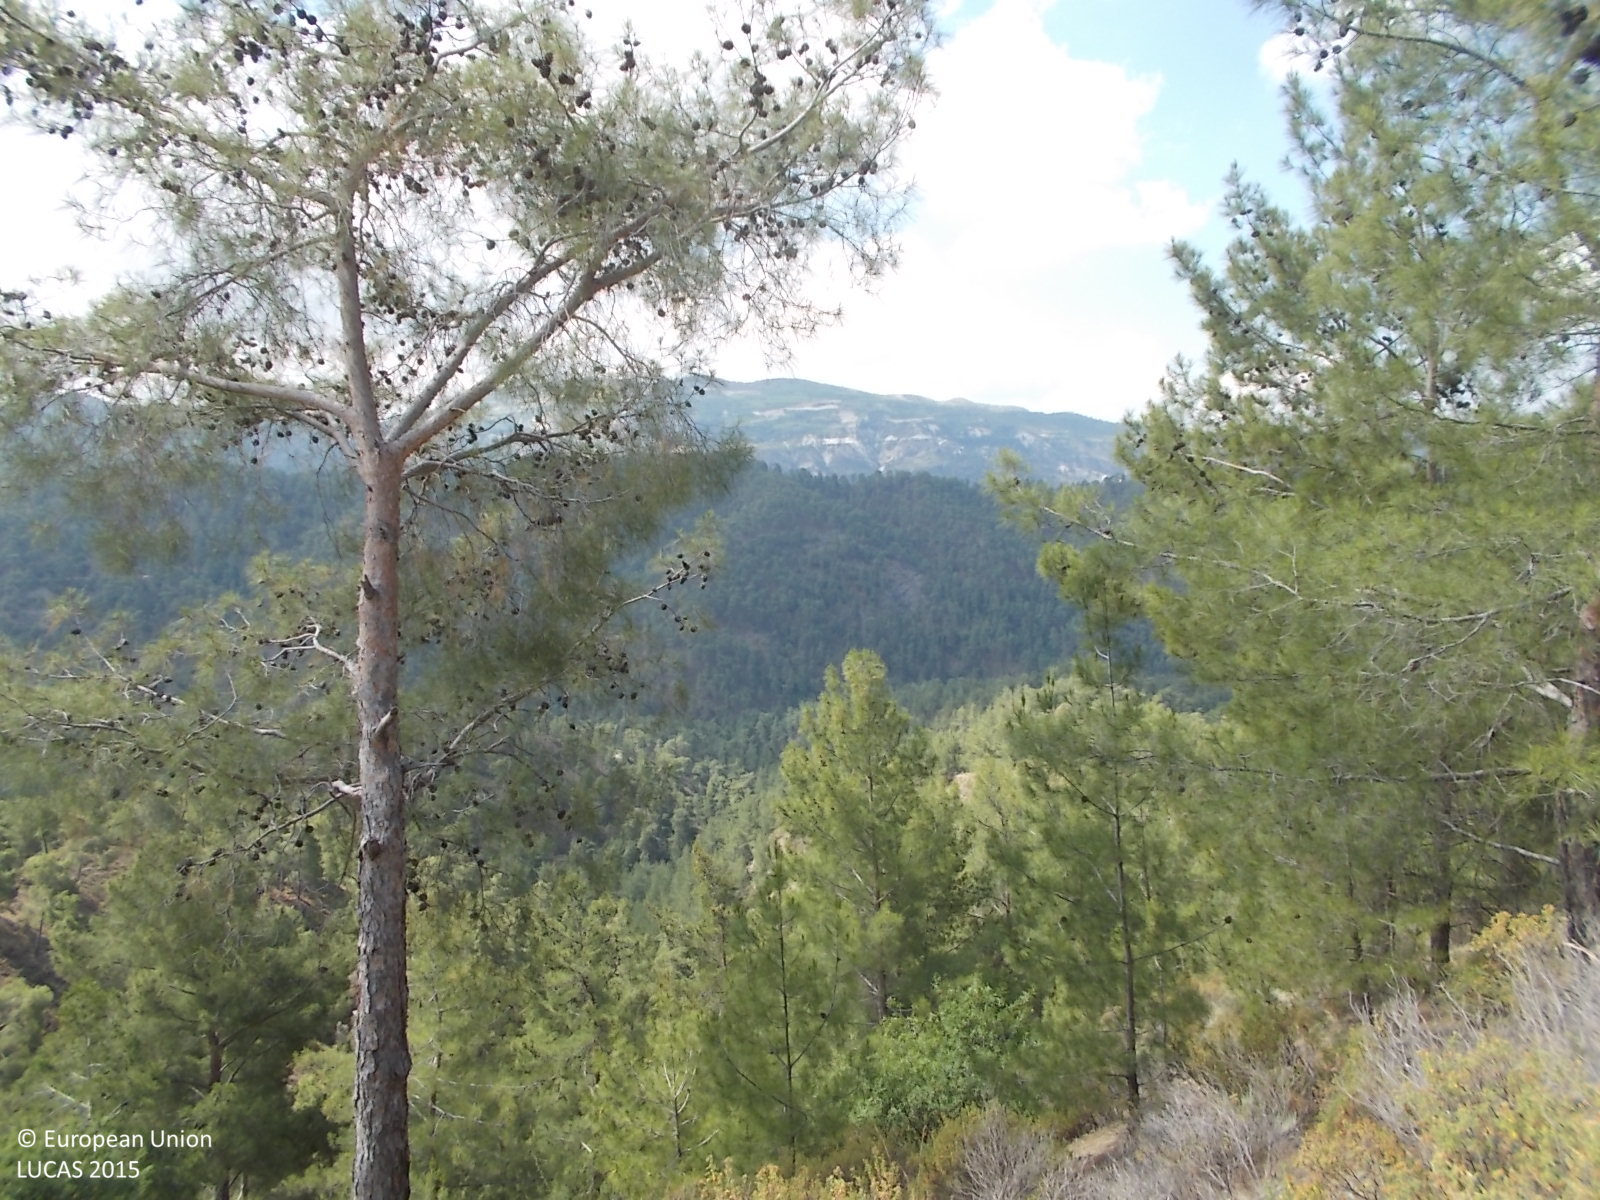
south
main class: Woodland
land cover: Pine dominated coniferous woodland
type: coniferous forest of the mediterranean region
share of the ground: 25 - 50 %
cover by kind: shrubs 35 %, unconsolidated bare surface 35 %, coniferous forest trees 30 %
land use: Forestry
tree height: > 5 m
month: June
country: CY
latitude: 34.9052
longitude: 32.7839
